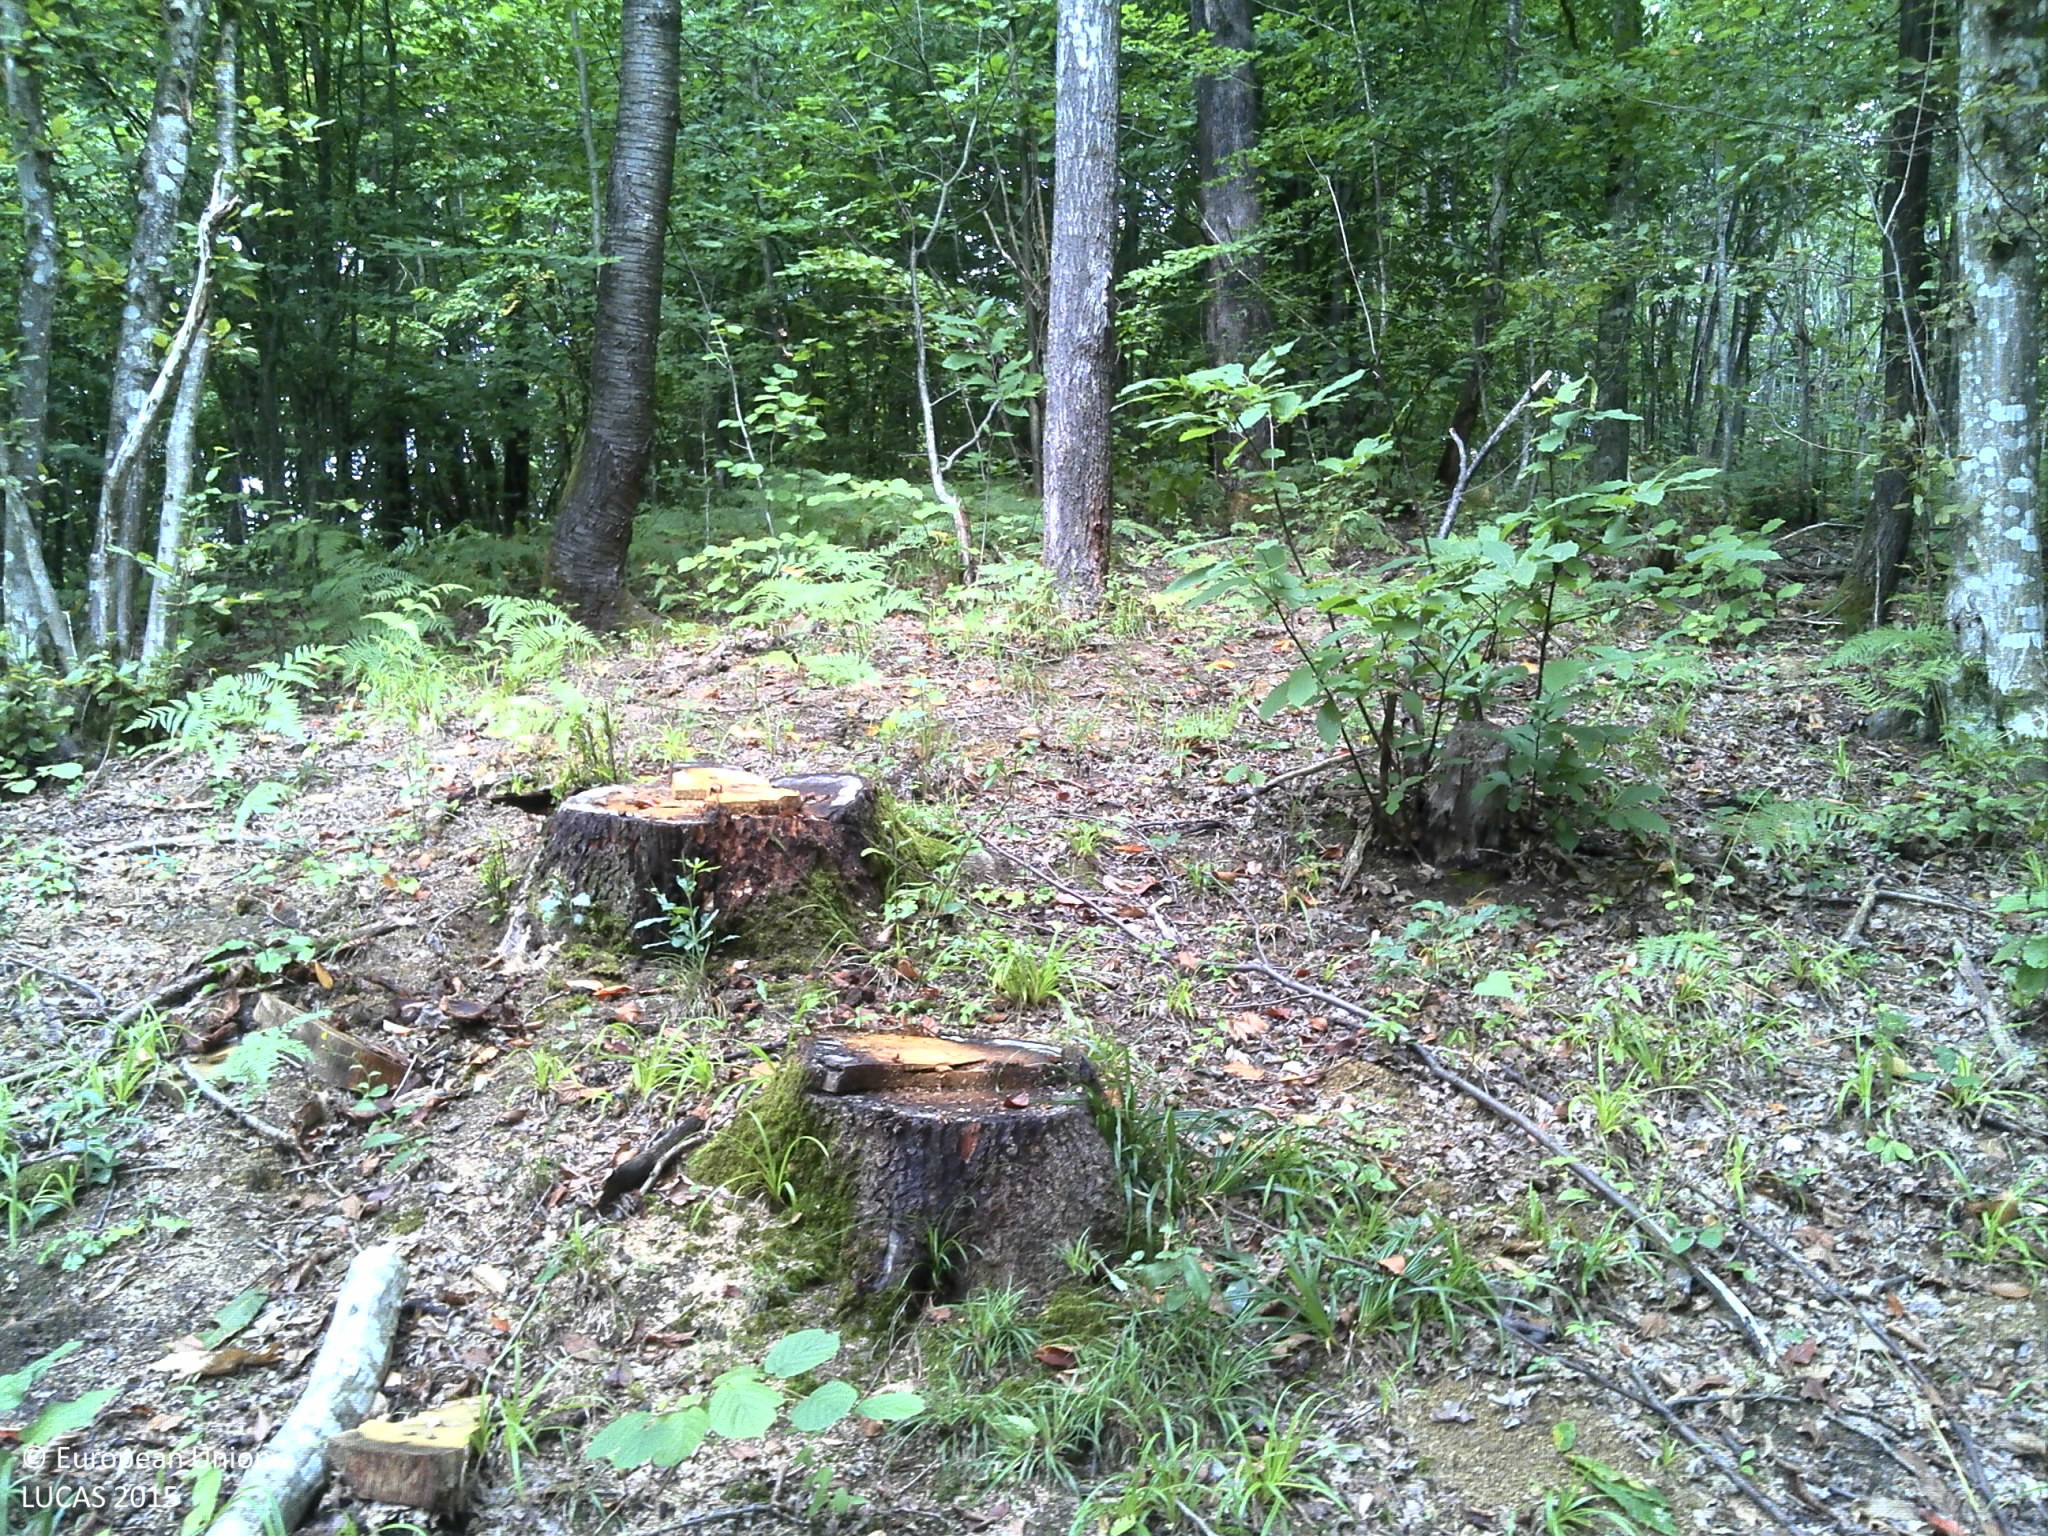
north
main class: Woodland
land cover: Broadleaved woodland
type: beech forest
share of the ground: > 75 %
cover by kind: broadleaved forest trees 100 %
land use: Forestry
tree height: > 5 m
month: August
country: HR
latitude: 45.2916
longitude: 16.1042
